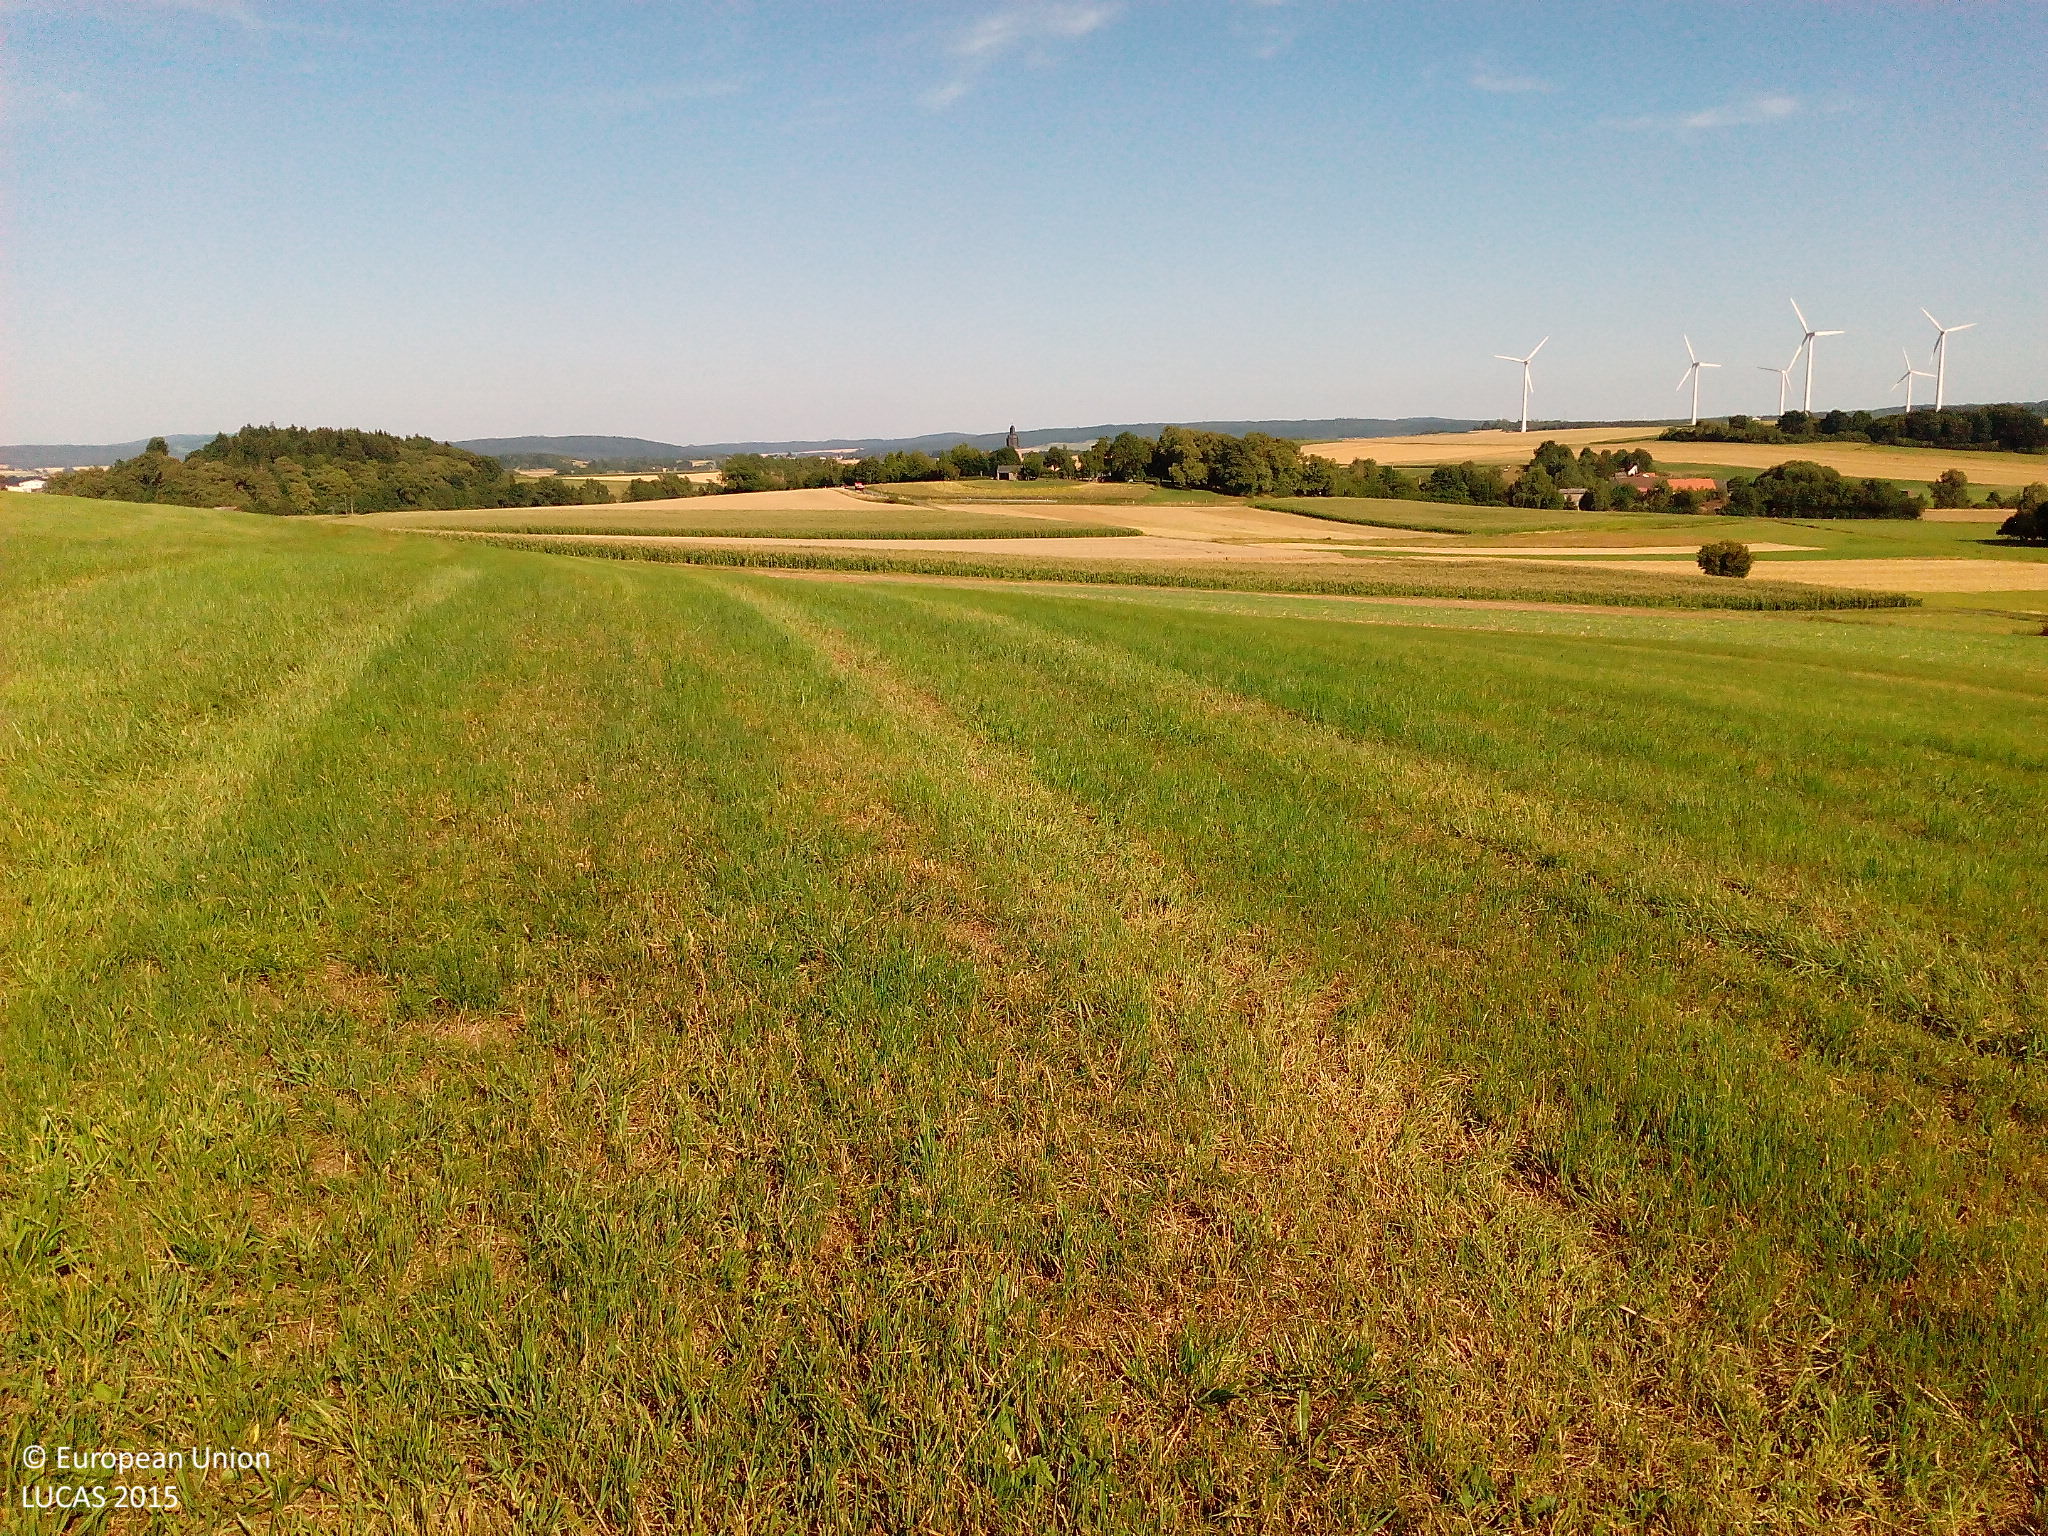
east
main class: Grassland
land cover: Grassland without tree/shrub cover
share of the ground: > 75 %
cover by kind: herbaceous plants 100 %
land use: Agriculture (excluding fallow land and kitchen gardens)
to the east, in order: Grassland without tree/shrub cover; Grass margins; Tracks; Grass margins; Maize
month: August
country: DE
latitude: 50.7568
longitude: 9.1922
